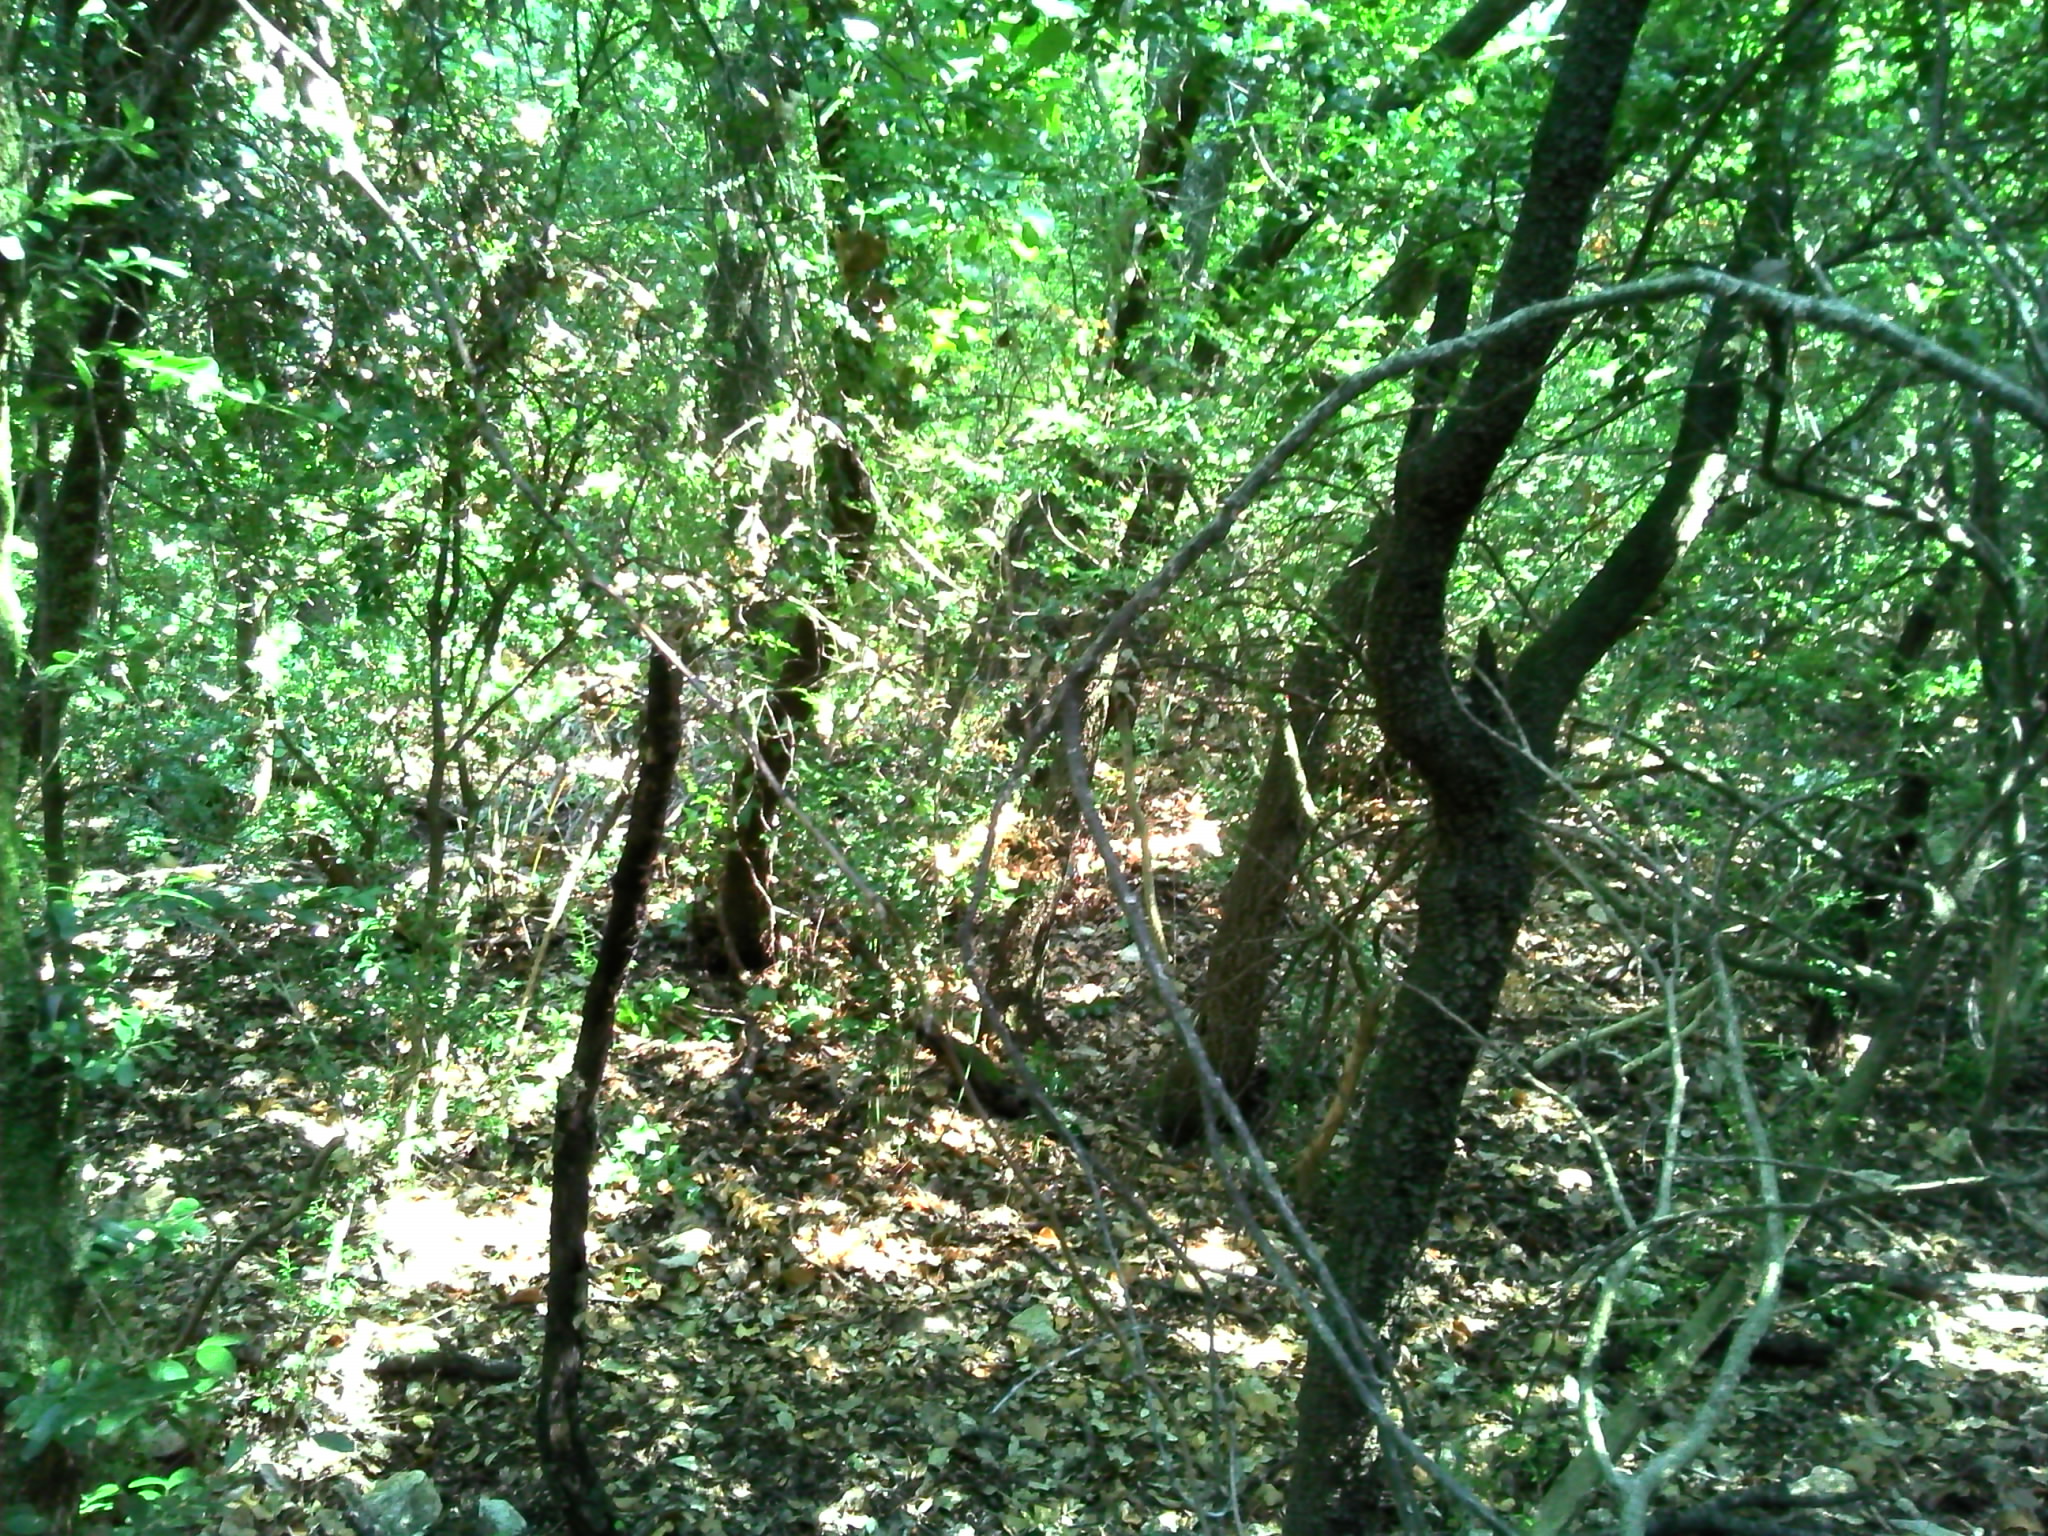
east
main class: Woodland
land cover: Broadleaved woodland
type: broadleaved evergreen forest
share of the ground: > 75 %
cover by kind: broadleaved forest trees 80 %, consolidated bare surface 15 %, herbaceous plants 5 %
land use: Forestry
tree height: > 5 m
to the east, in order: Broadleaved woodland; Tracks; Broadleaved woodland
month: August
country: FR
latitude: 43.9961
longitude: 4.6587
